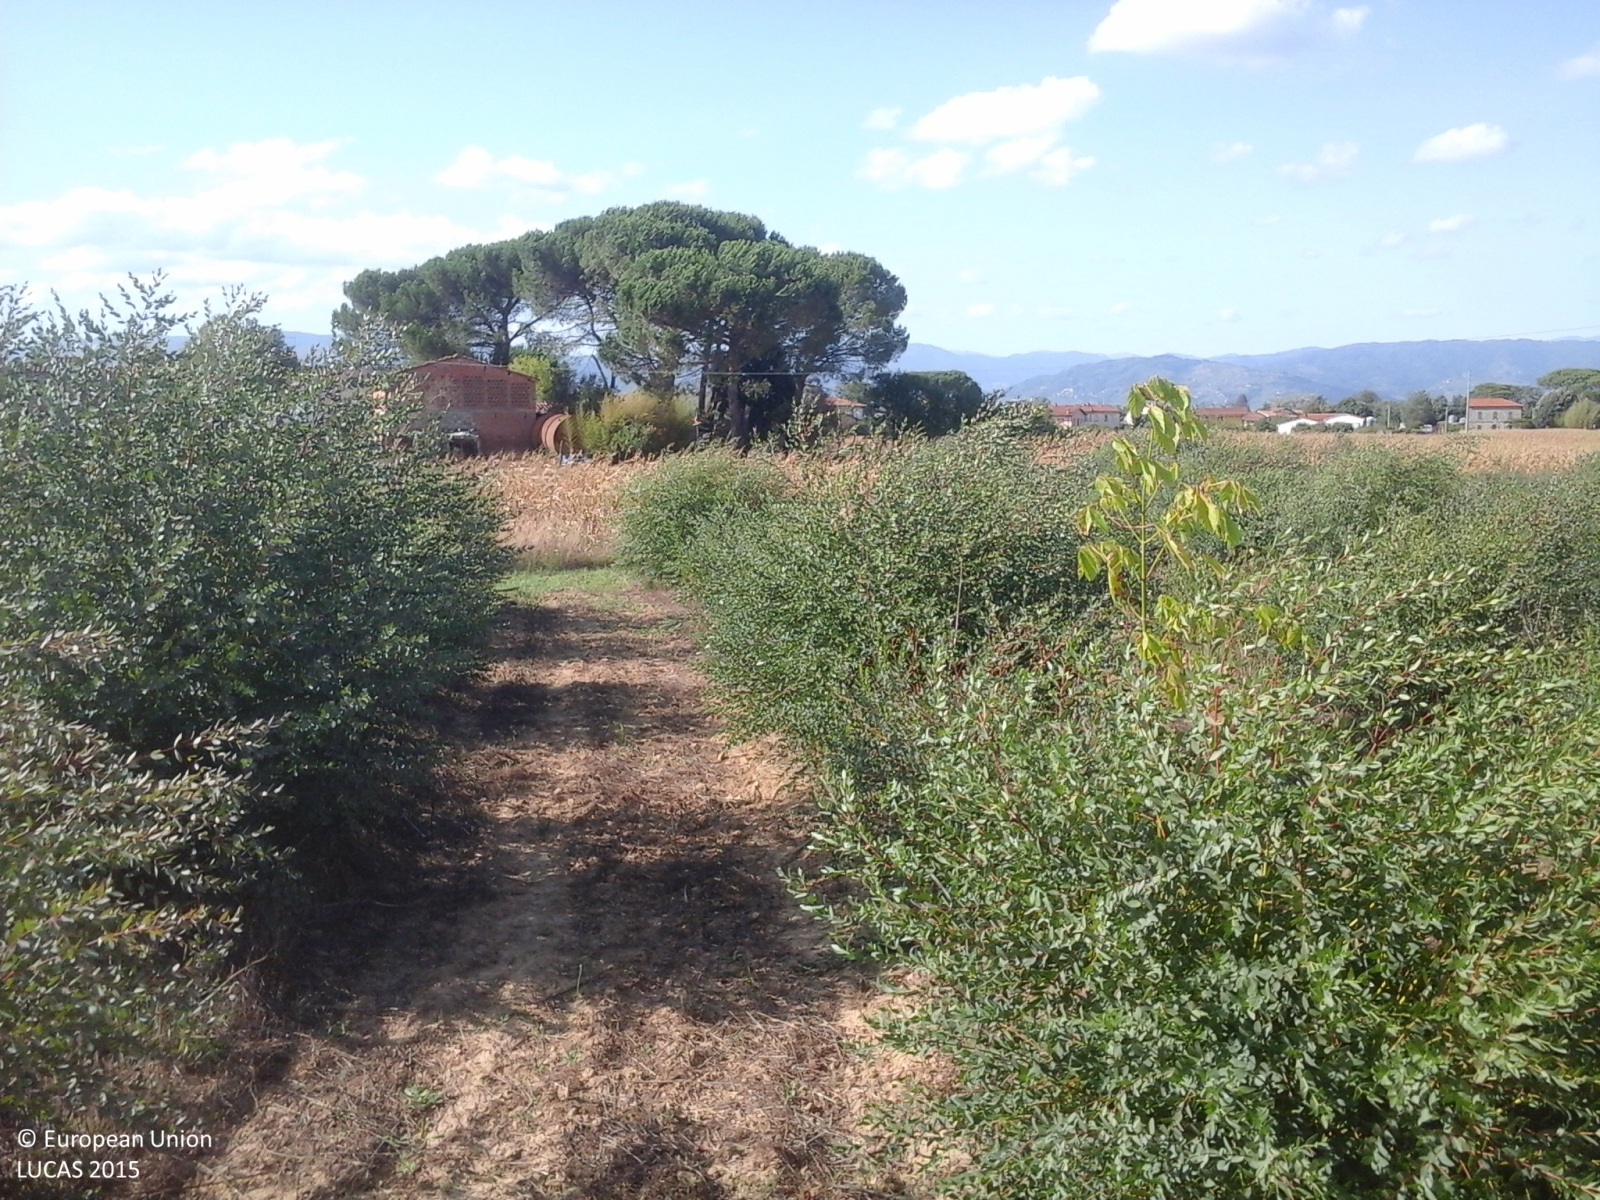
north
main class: Cropland
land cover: Nurseries
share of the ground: > 75 %
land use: Agriculture (excluding fallow land and kitchen gardens)
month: August
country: IT
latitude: 43.8069
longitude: 10.7067
